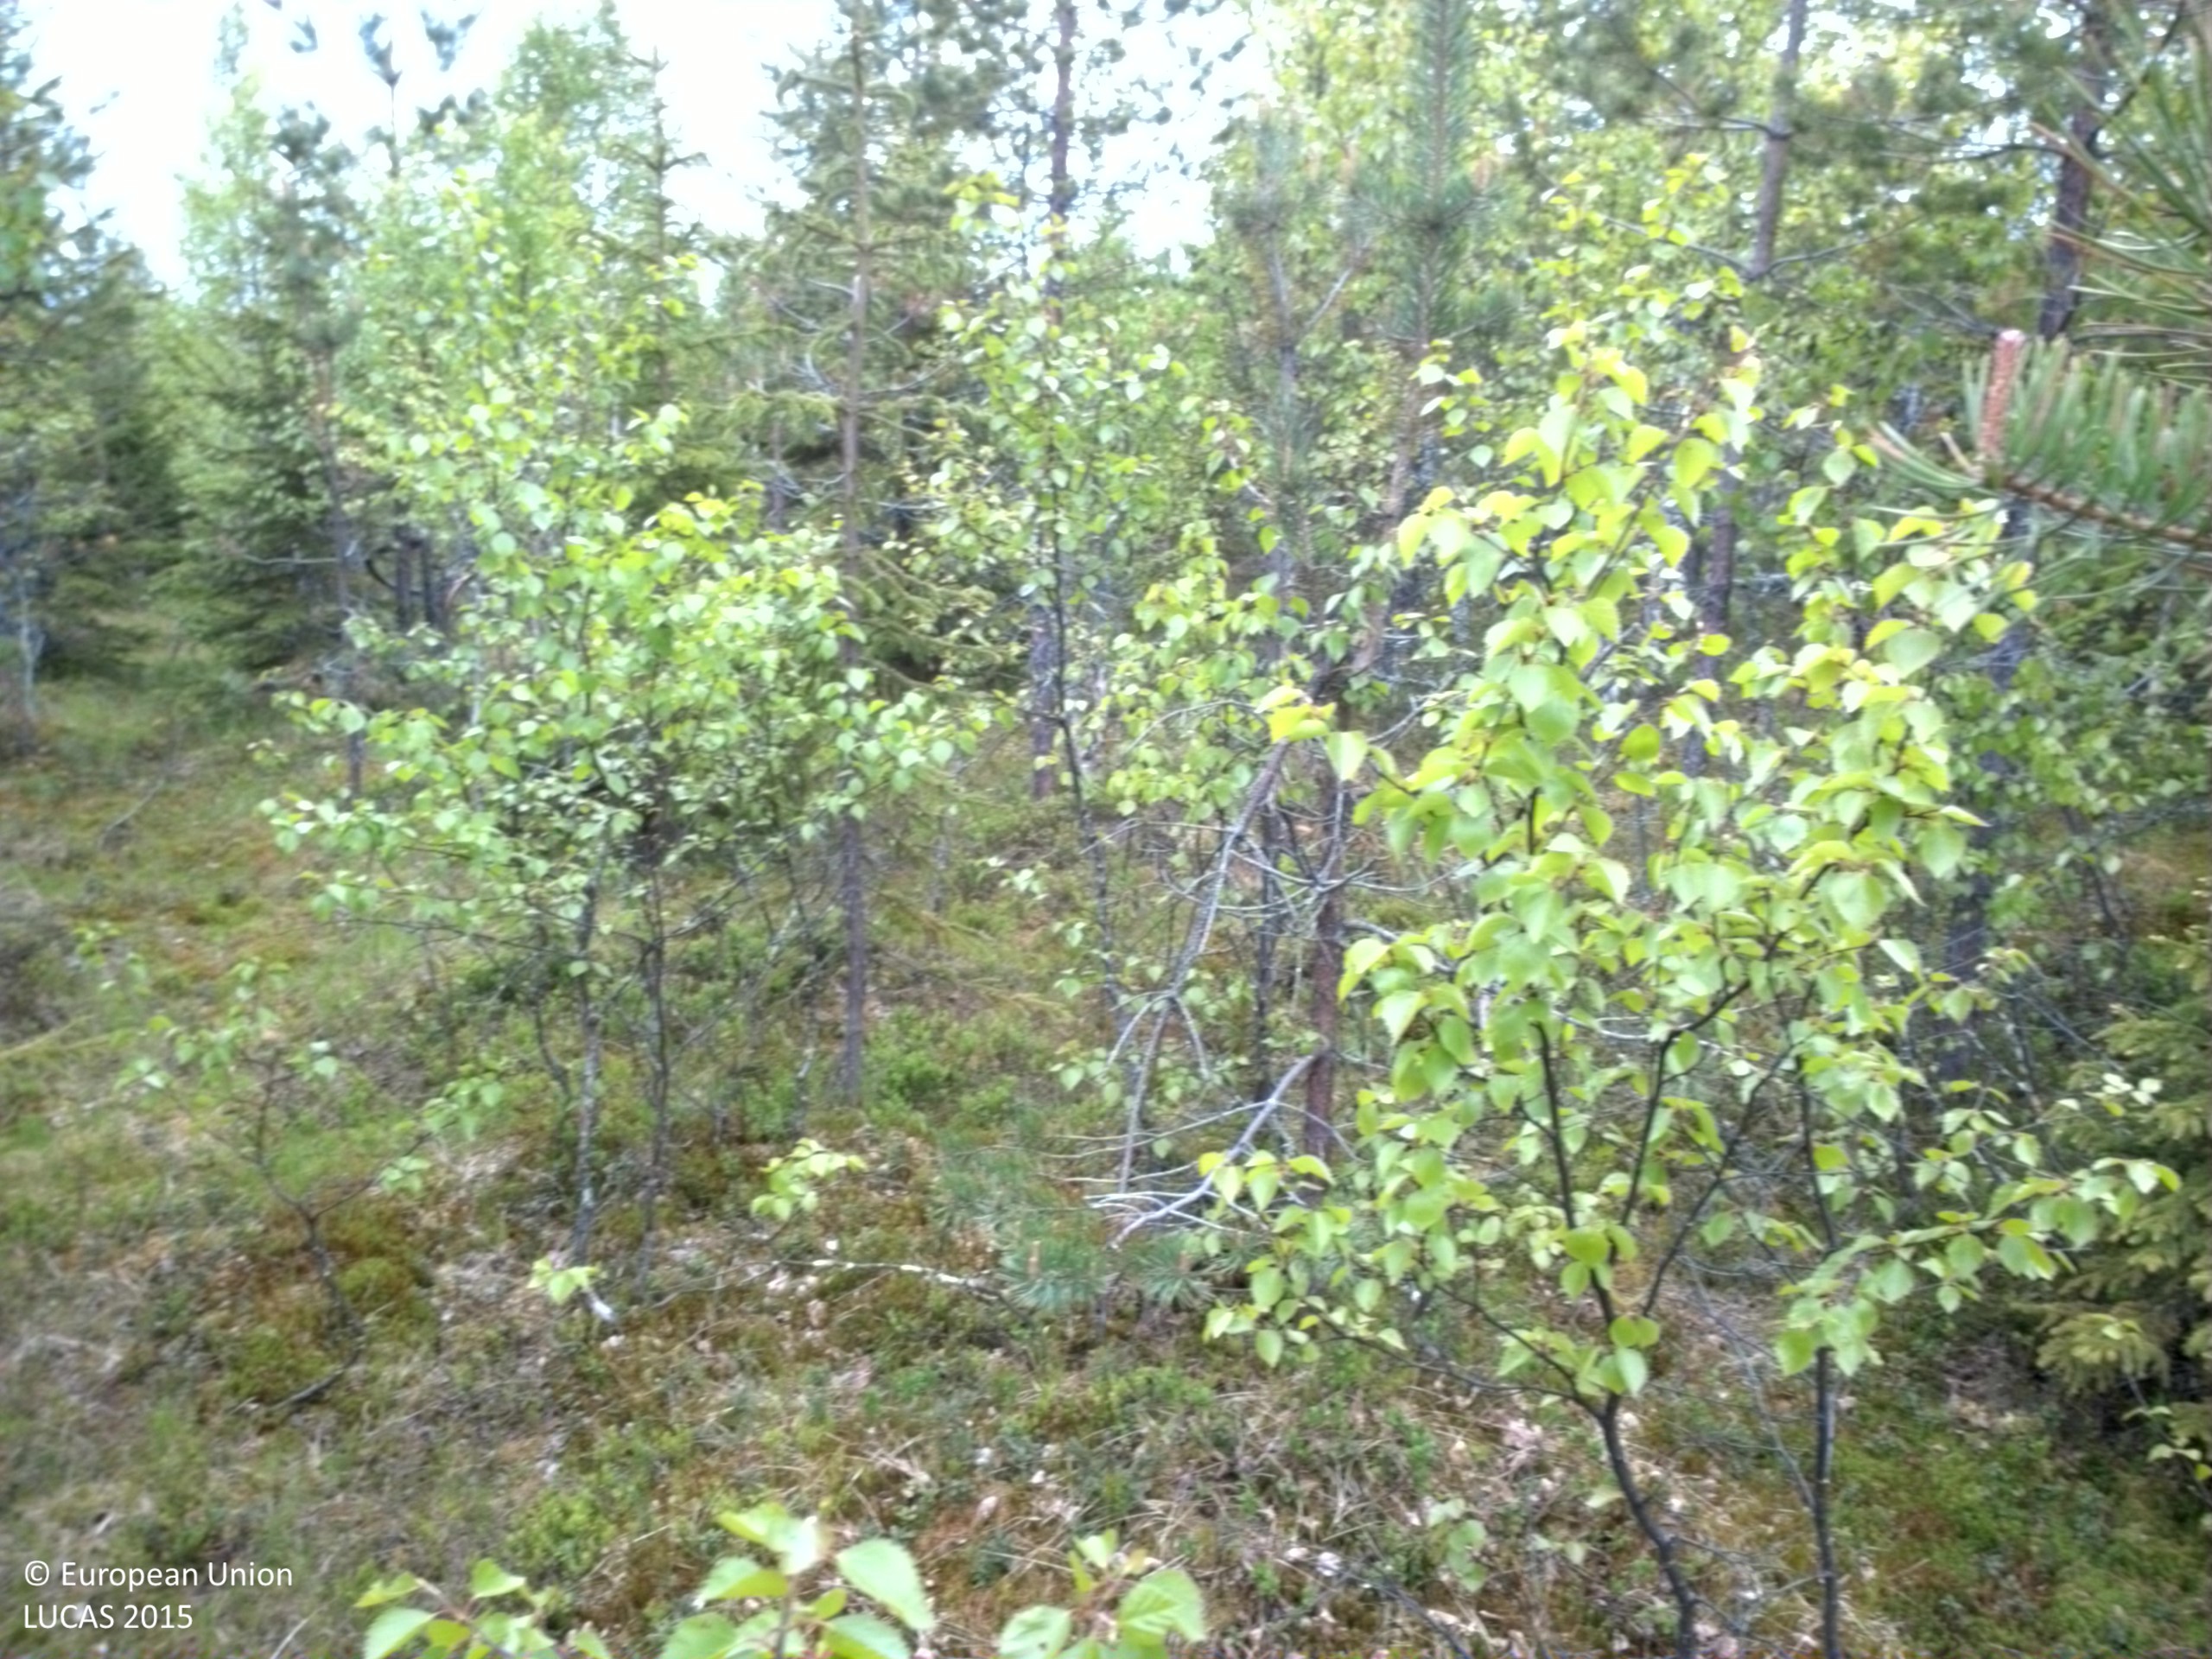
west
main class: Woodland
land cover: Pine dominated mixed woodland
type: boreal forest
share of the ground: 50 - 75 %
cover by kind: coniferous forest trees 45 %, shrubs 40 %, broadleaved forest trees 15 %
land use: Forestry
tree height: < 5 m
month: June
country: SE
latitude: 63.1626
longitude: 17.9782
